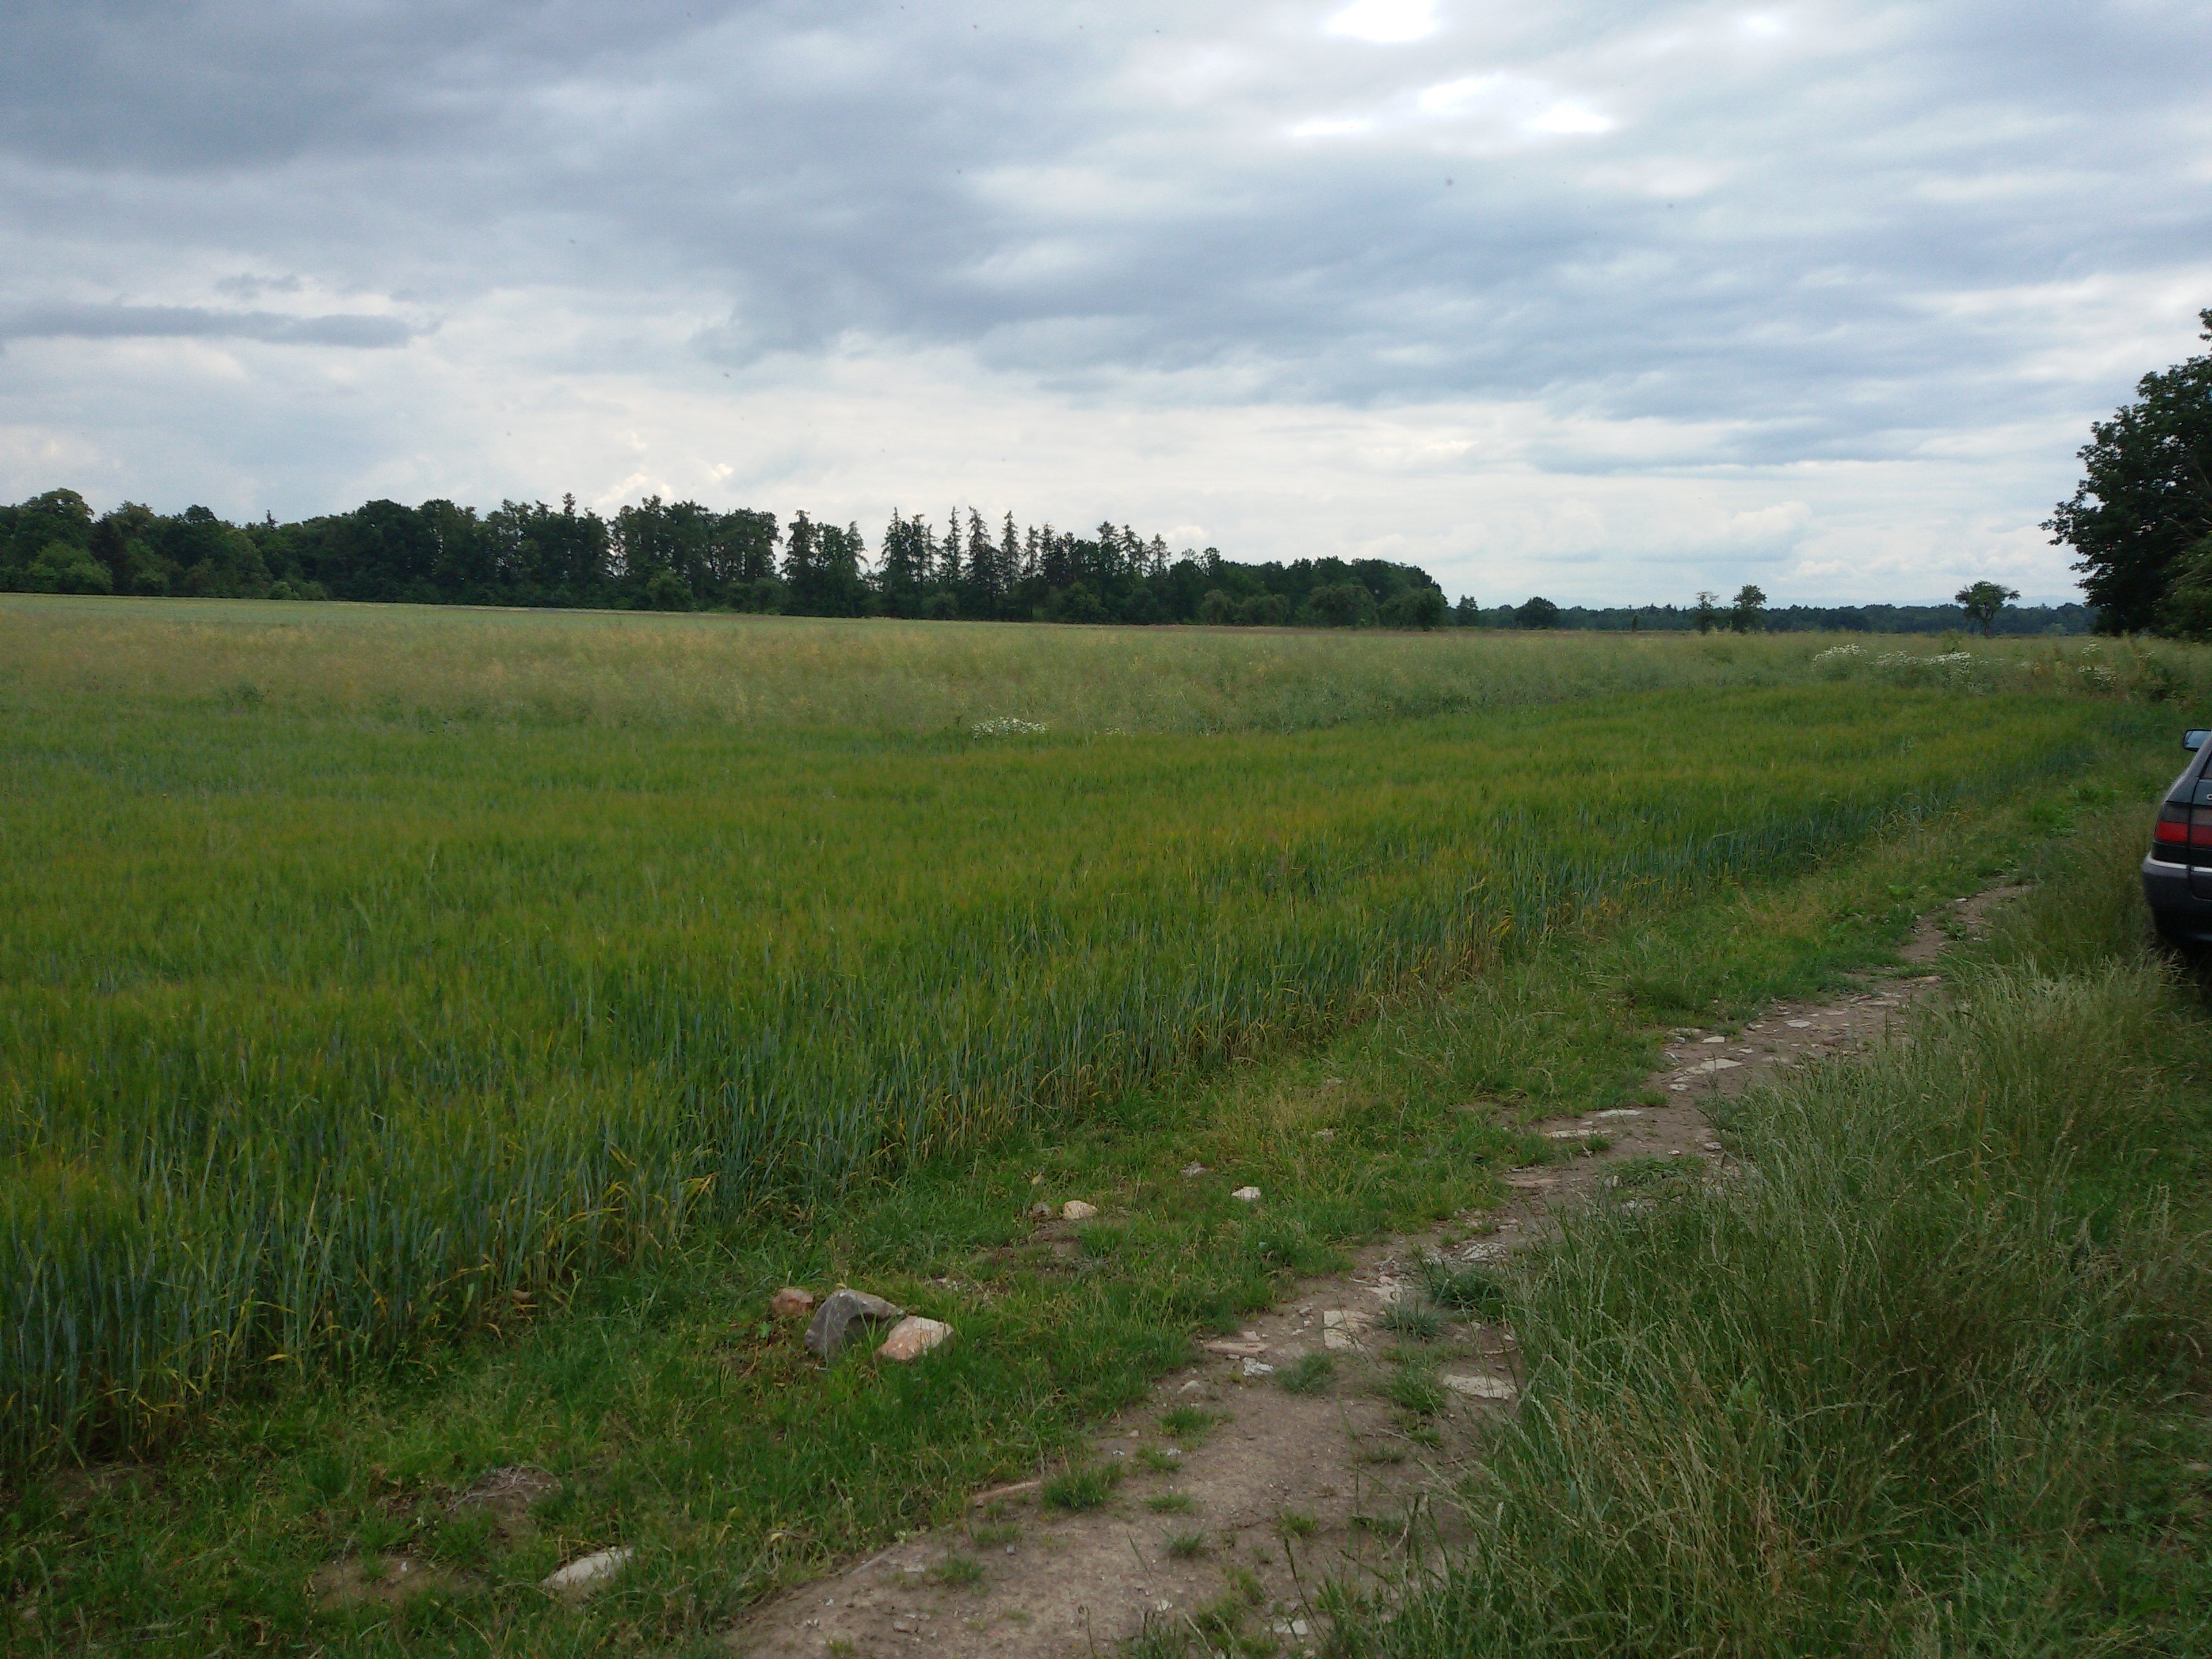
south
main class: Shrubland
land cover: Shrubland with sparse tree cover
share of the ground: > 75 %
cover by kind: shrubs 95 %, broadleaved forest trees 5 %
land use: Semi-natural and natural areas not in use
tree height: < 5 m
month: June
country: PL
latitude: 50.7314
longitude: 17.2226
